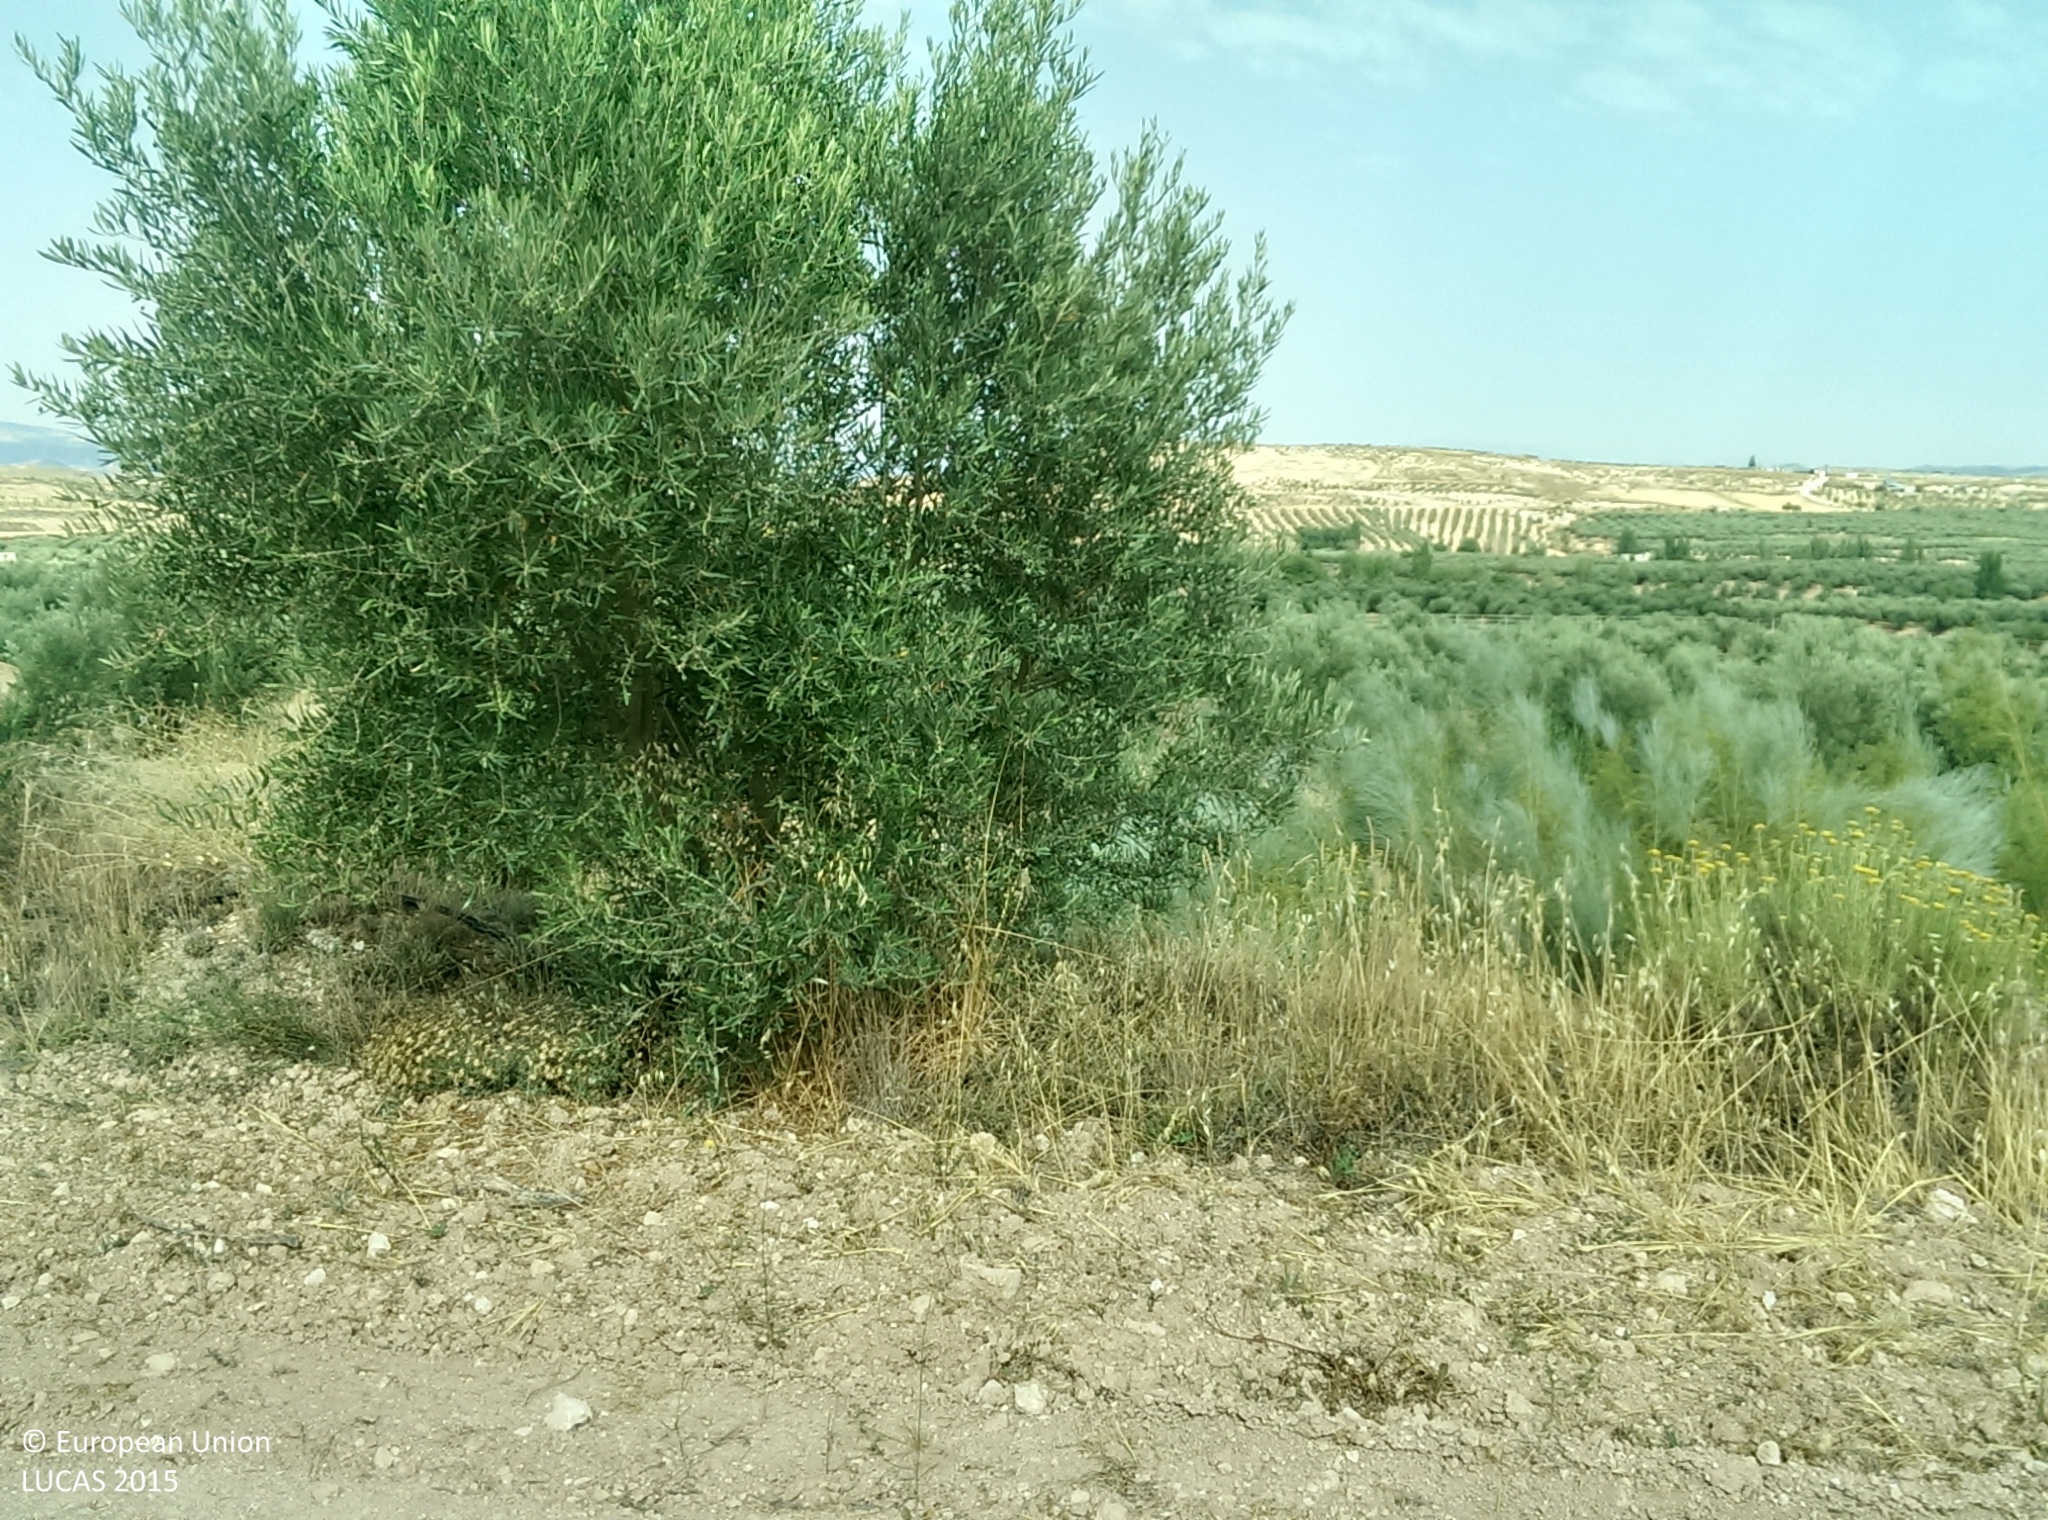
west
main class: Cropland
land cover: Olive groves
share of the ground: 10 - 25 %
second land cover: Spontaneously vegetated surfaces
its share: 50 - 75 %
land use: Agriculture (excluding fallow land and kitchen gardens)
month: July
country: ES
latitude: 37.5937
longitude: -2.9351
